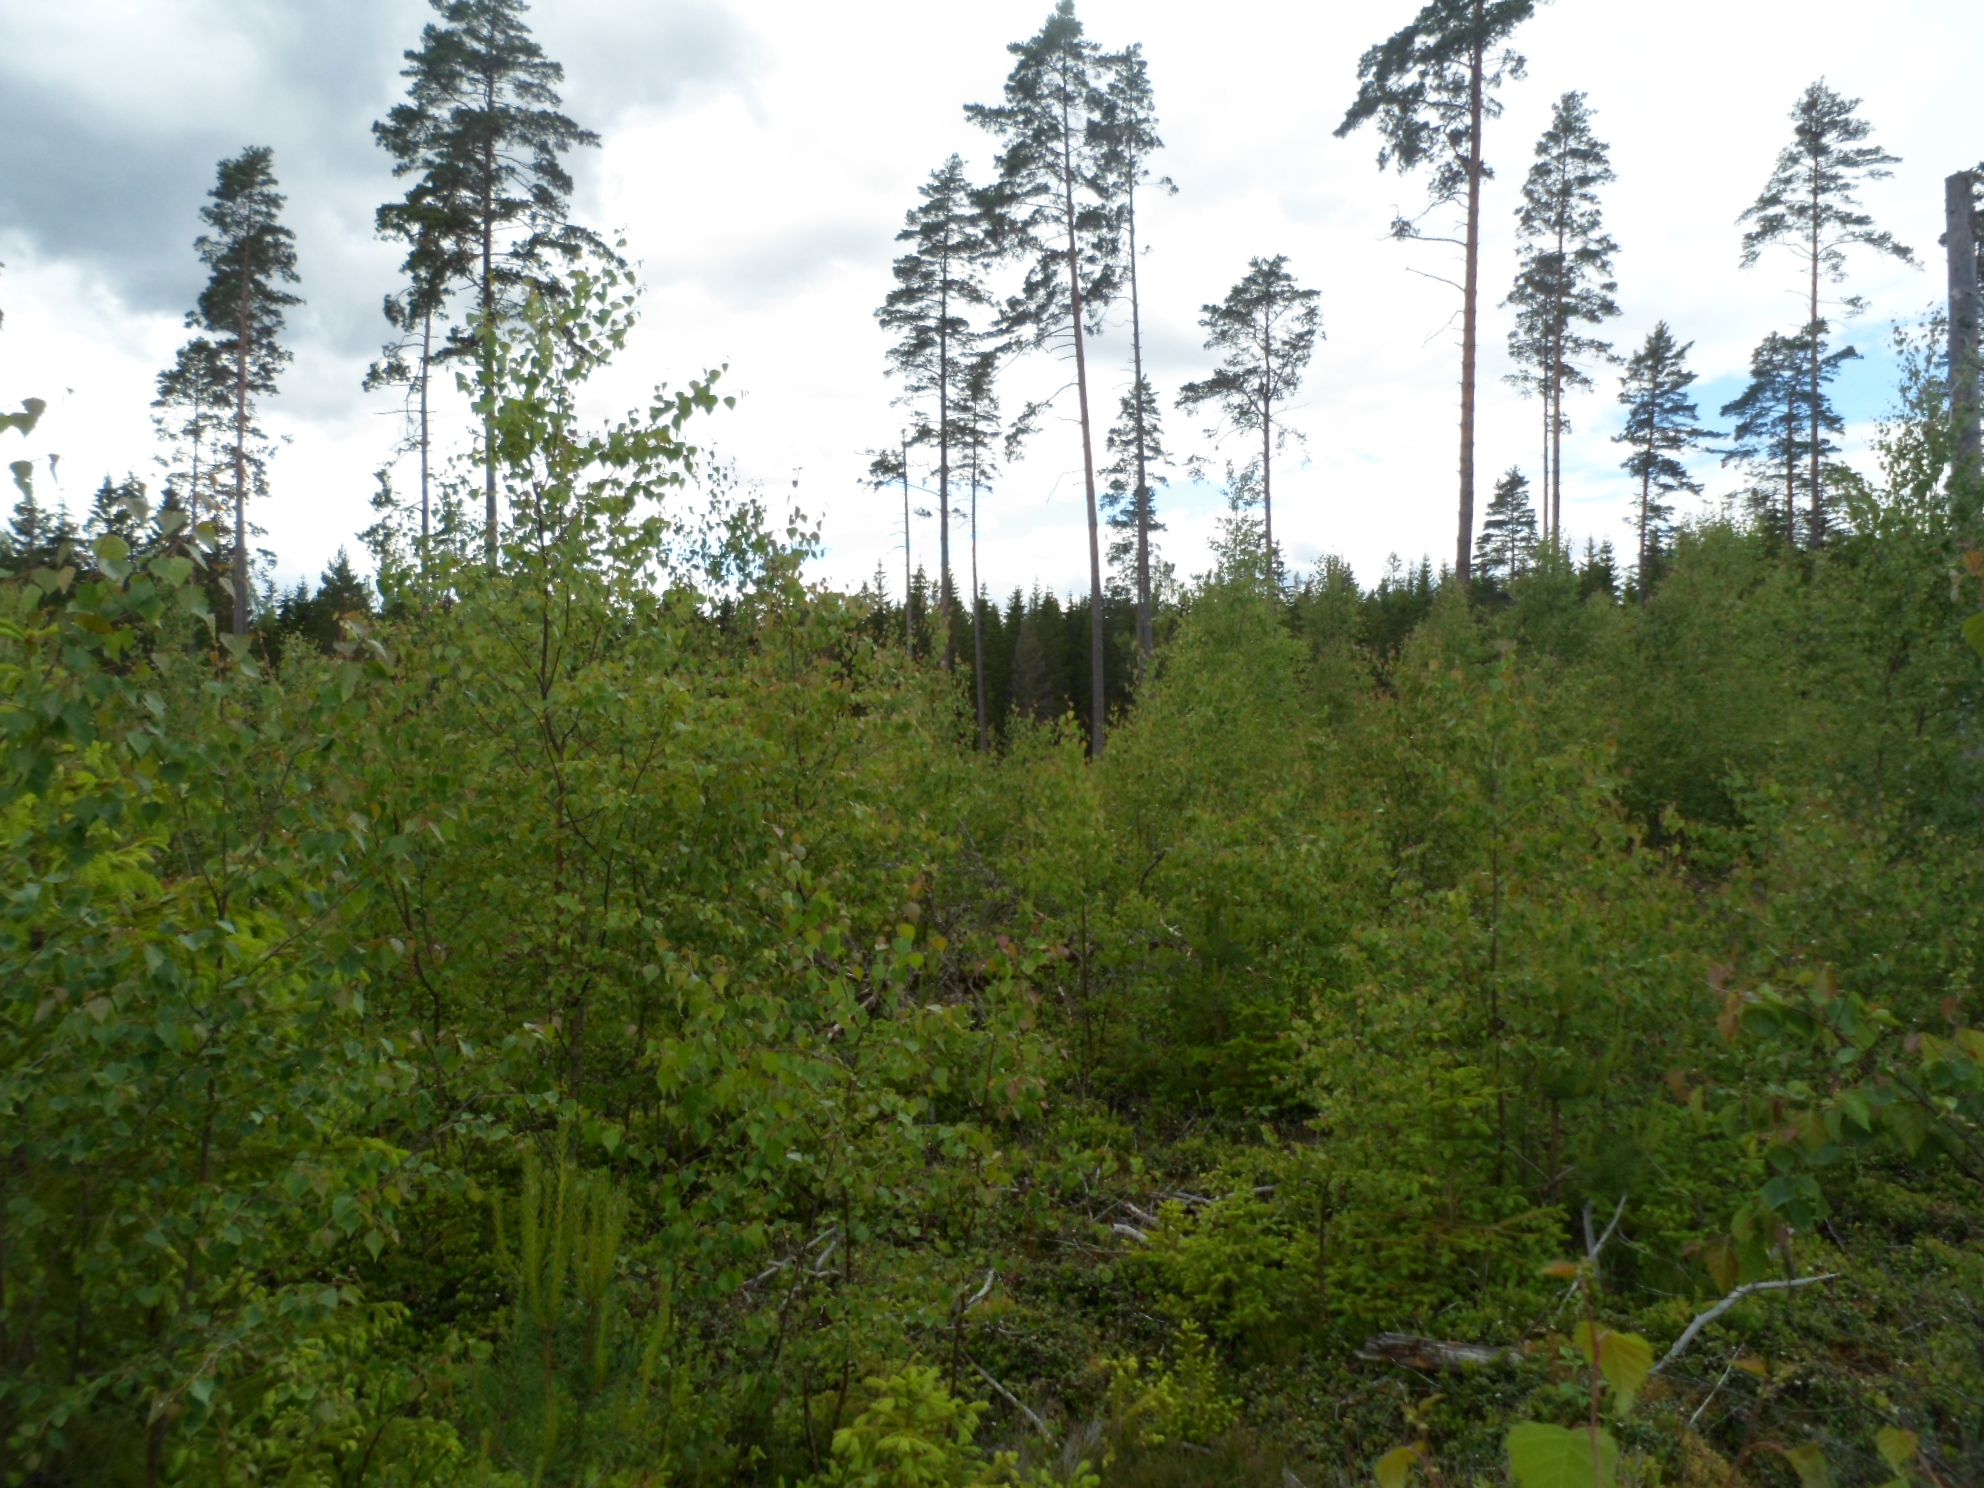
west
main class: Woodland
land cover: Pine dominated mixed woodland
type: boreal forest
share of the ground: 25 - 50 %
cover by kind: shrubs 40 %, coniferous forest trees 20 %, broadleaved forest trees 20 %, herbaceous plants 10 %, lichens and mosses 10 %
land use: Forestry
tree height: < 5 m
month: June
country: SE
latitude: 57.1038
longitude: 14.3711
